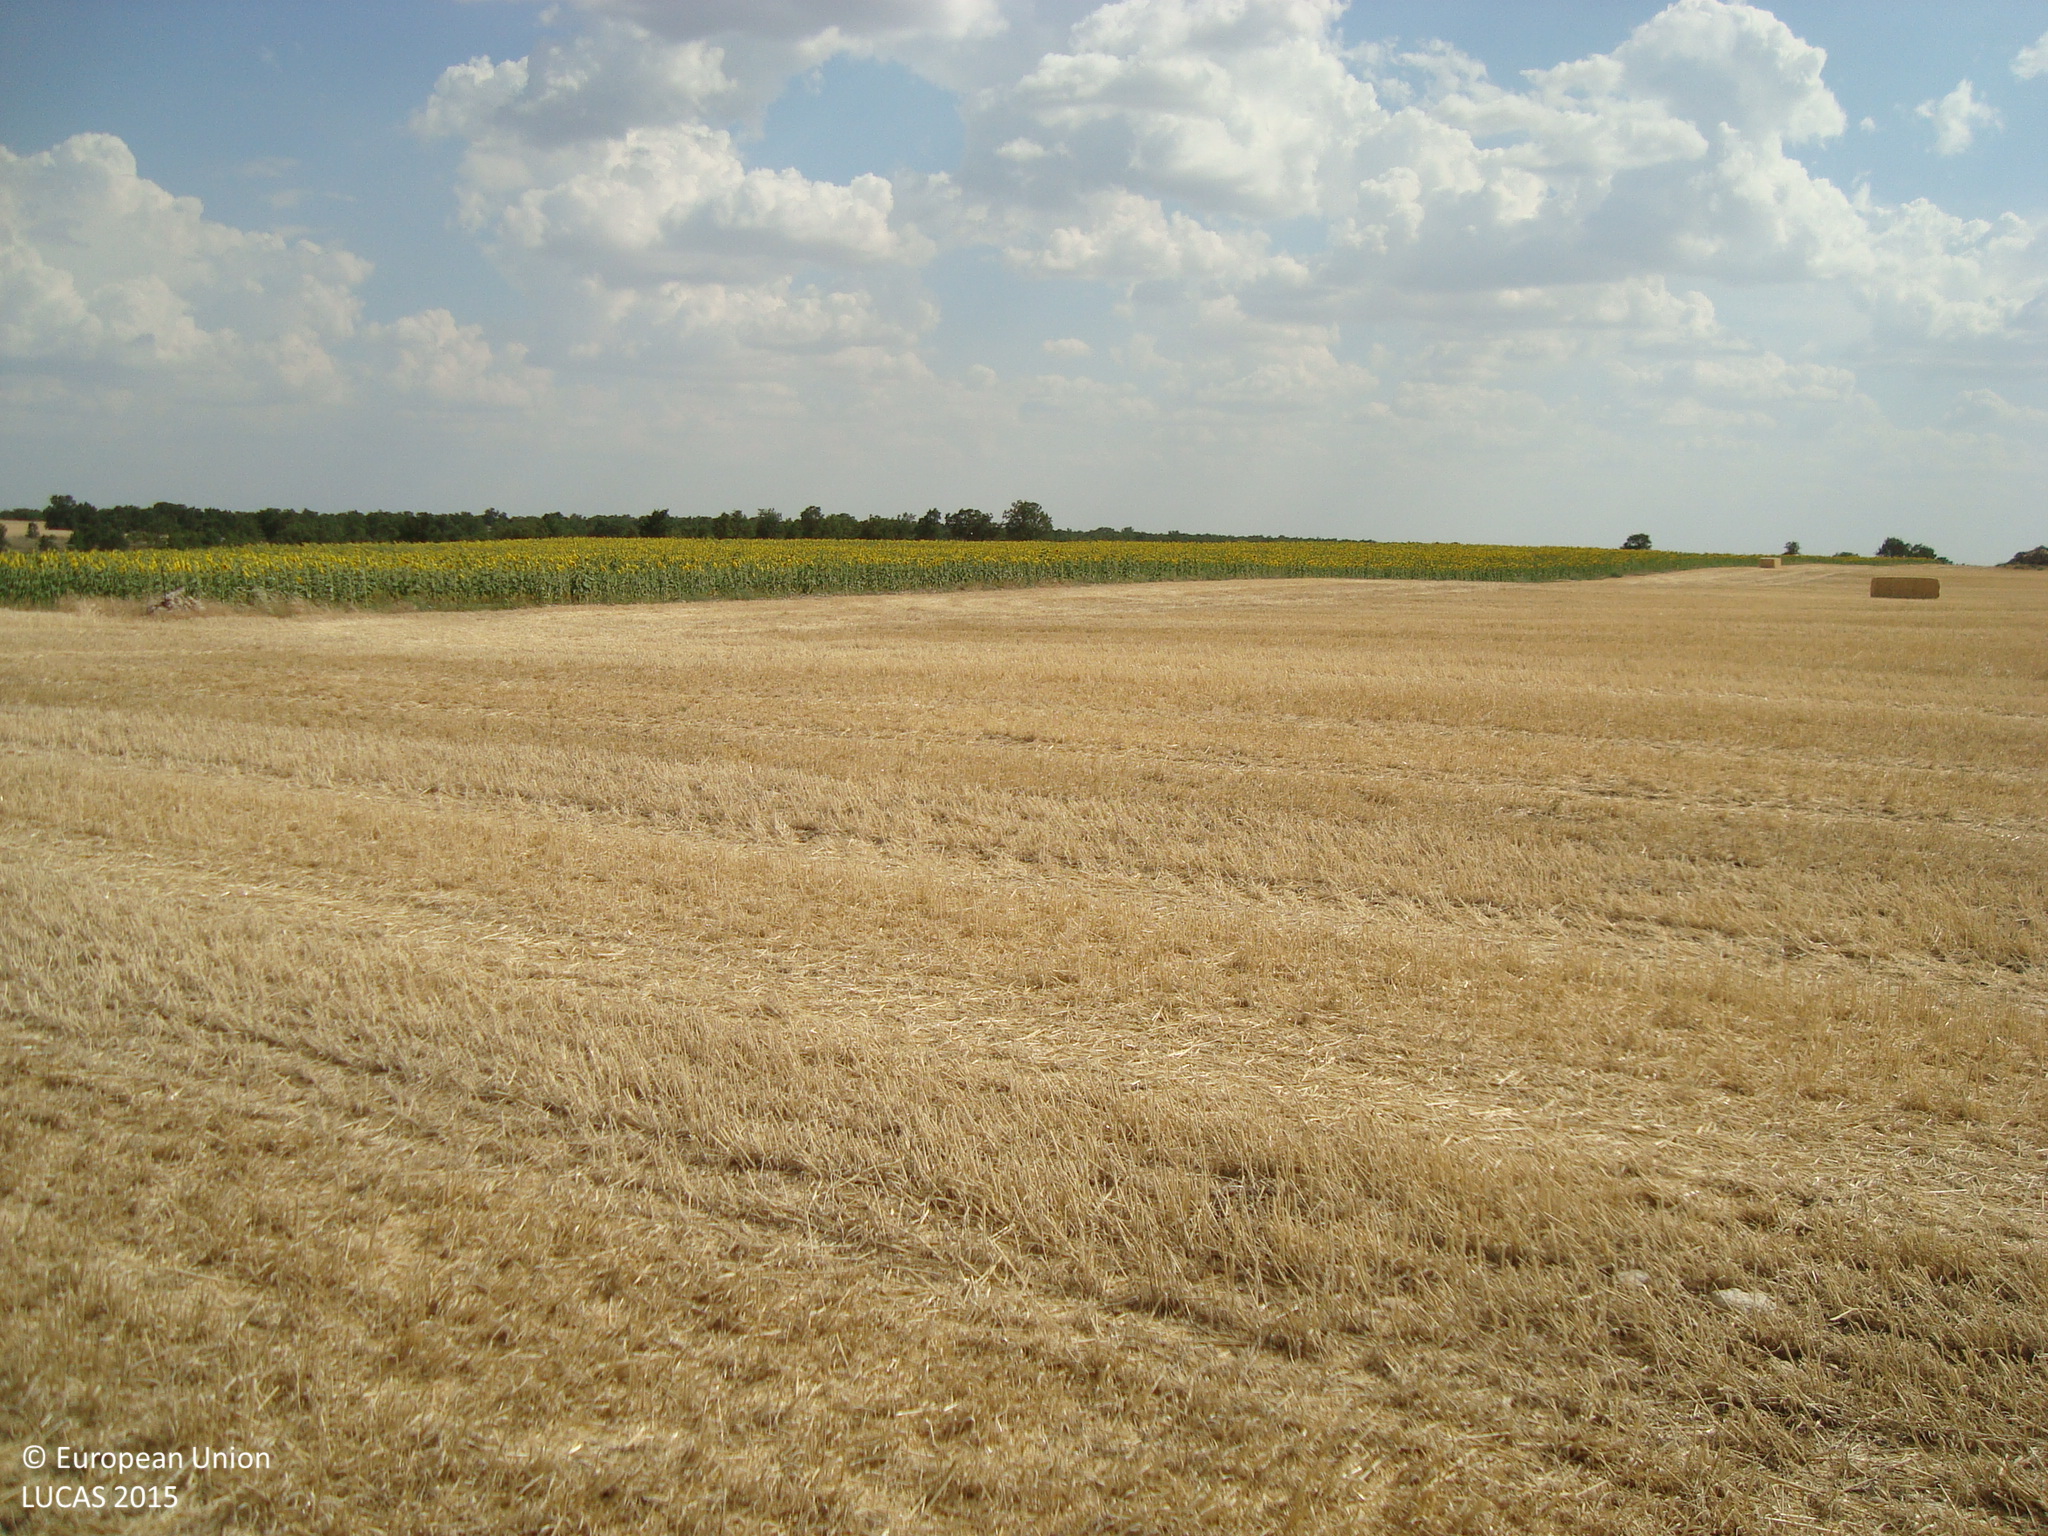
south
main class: Cropland
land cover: Barley
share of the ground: > 75 %
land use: Agriculture (excluding fallow land and kitchen gardens)
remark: Harvested field
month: July
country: ES
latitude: 41.9914
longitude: -4.1016
